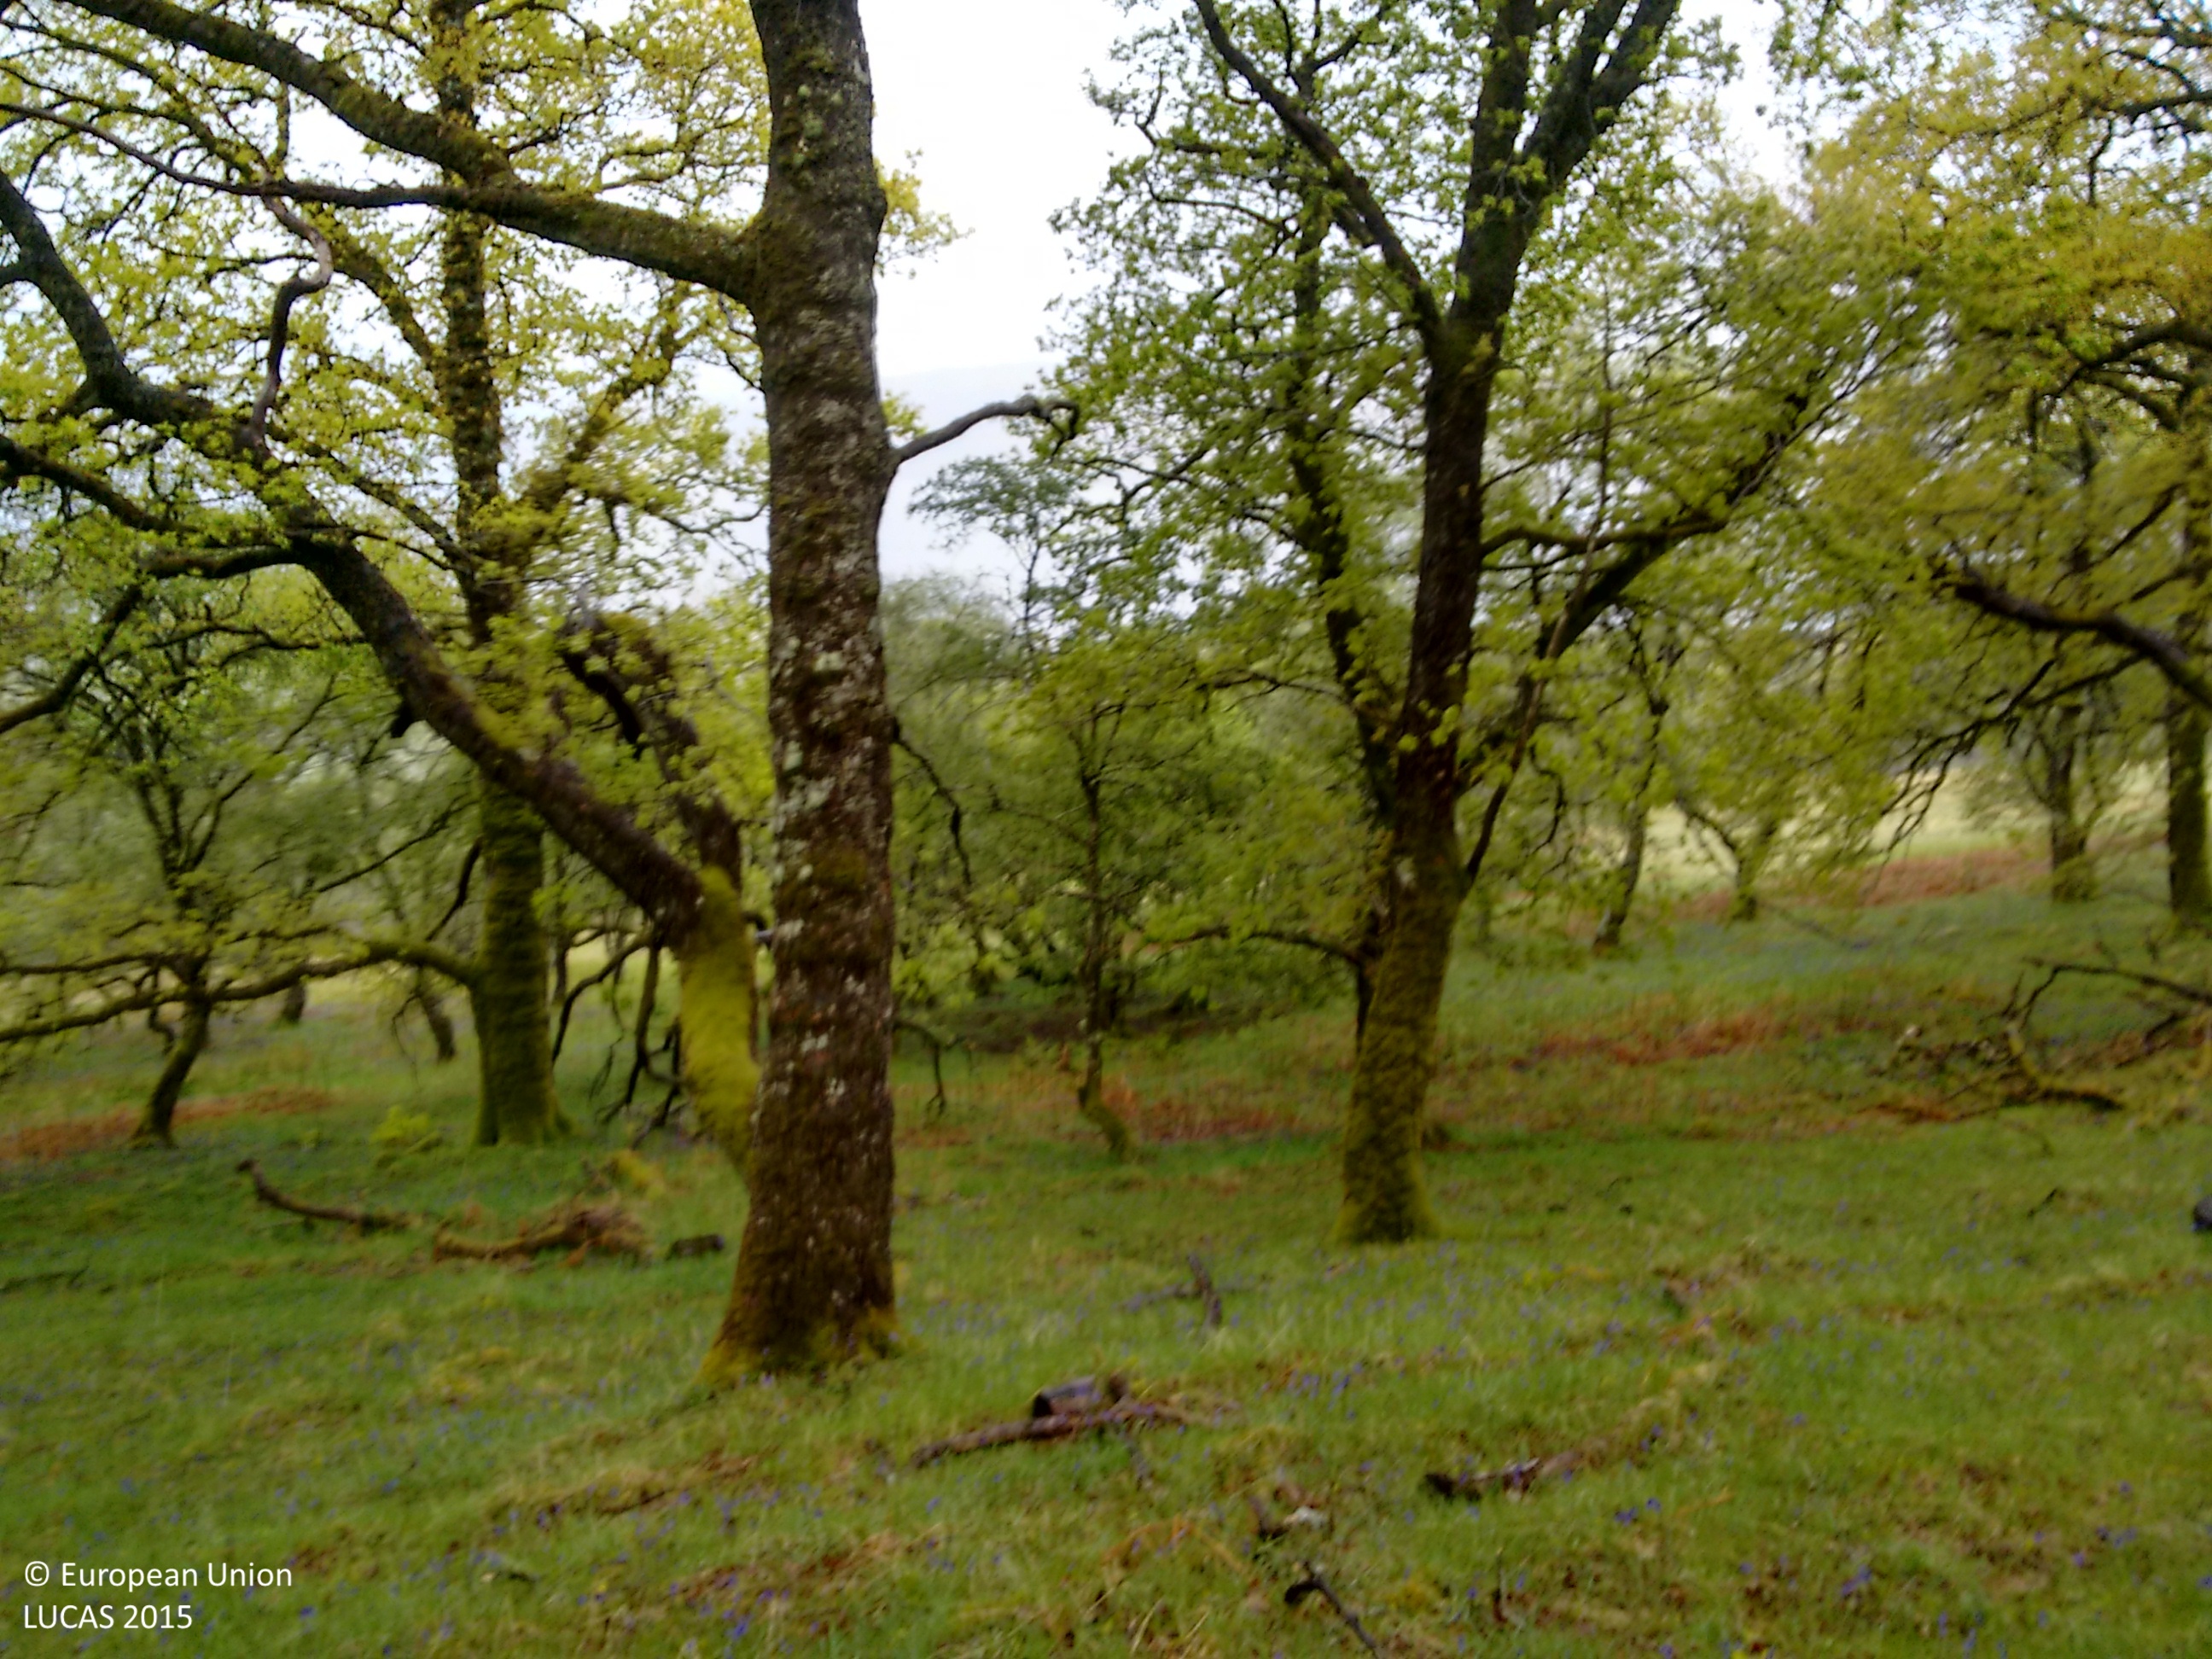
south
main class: Woodland
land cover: Broadleaved woodland
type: acidophilous oak and oak-birch forest
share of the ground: > 75 %
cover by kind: broadleaved forest trees 100 %
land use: Semi-natural and natural areas not in use
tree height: > 5 m
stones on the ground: 10 - 25 %
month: June
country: GB
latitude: 56.1548
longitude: -5.1990
